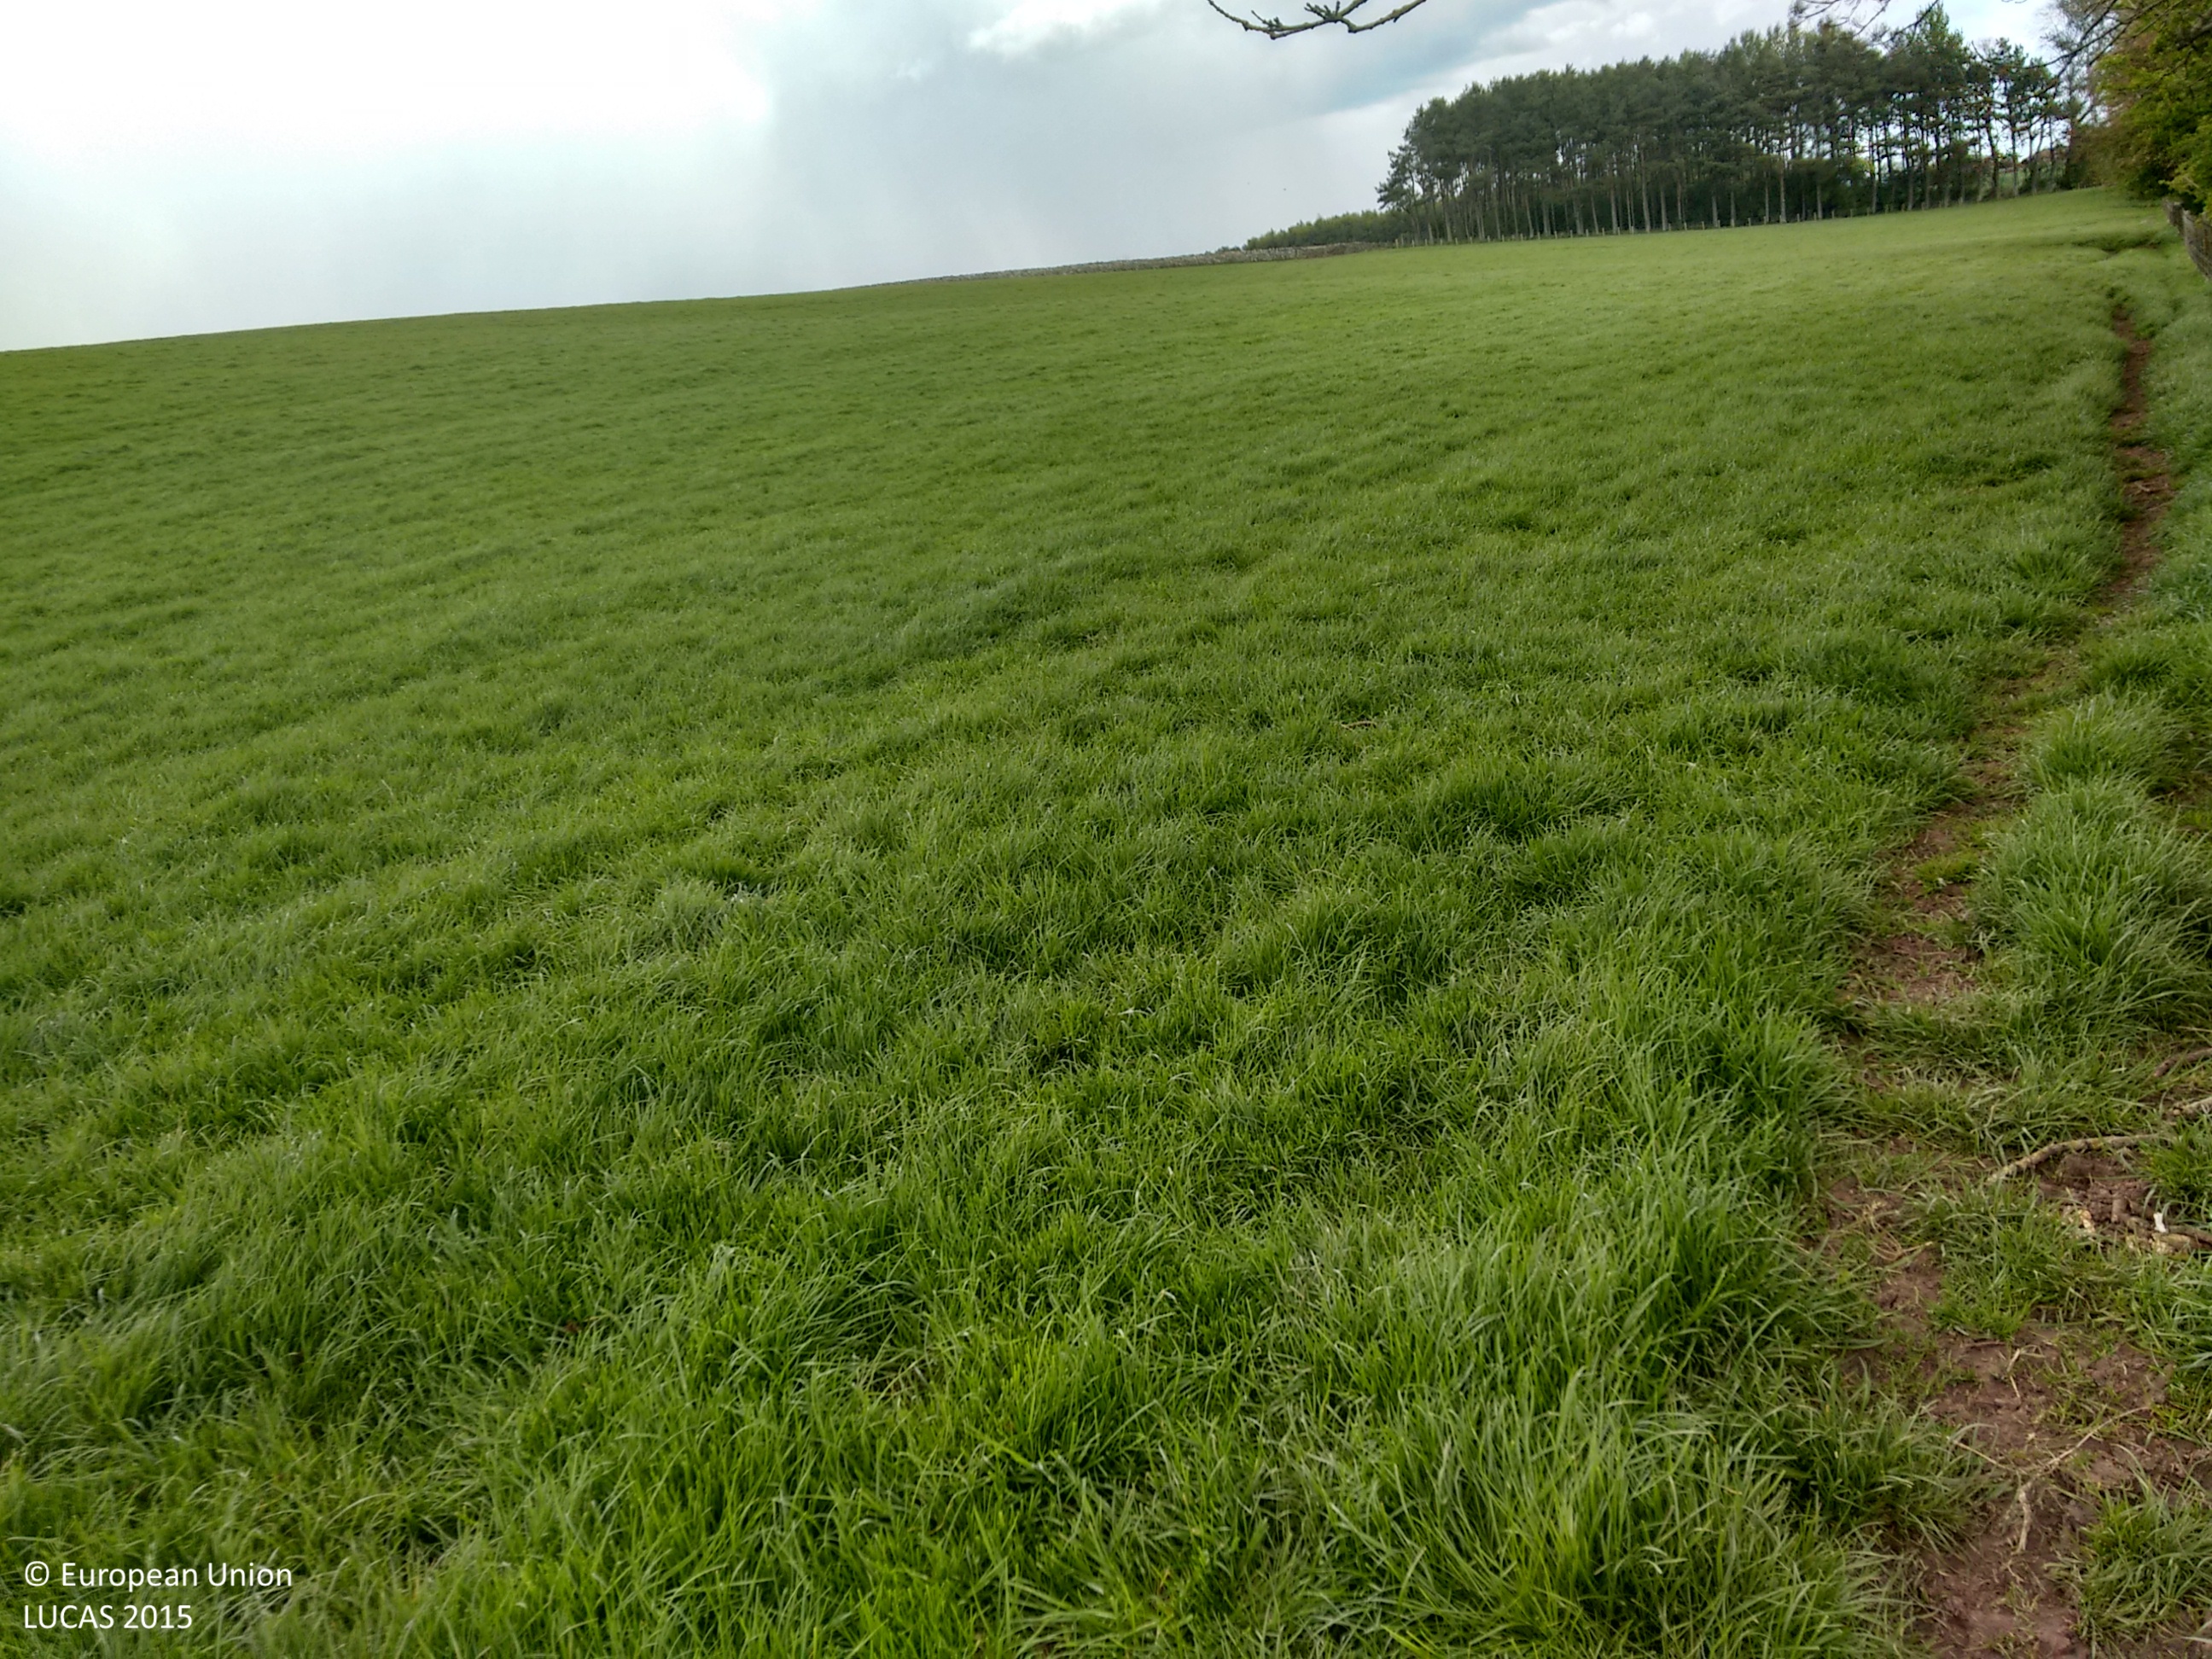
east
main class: Grassland
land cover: Grassland without tree/shrub cover
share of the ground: > 75 %
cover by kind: herbaceous plants 100 %
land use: Agriculture (excluding fallow land and kitchen gardens)
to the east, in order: Grassland without tree/shrub cover; Fences; Lines of trees; Fences; Grassland without tree/shrub cover
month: May
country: GB
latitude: 55.8122
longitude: -2.2959
